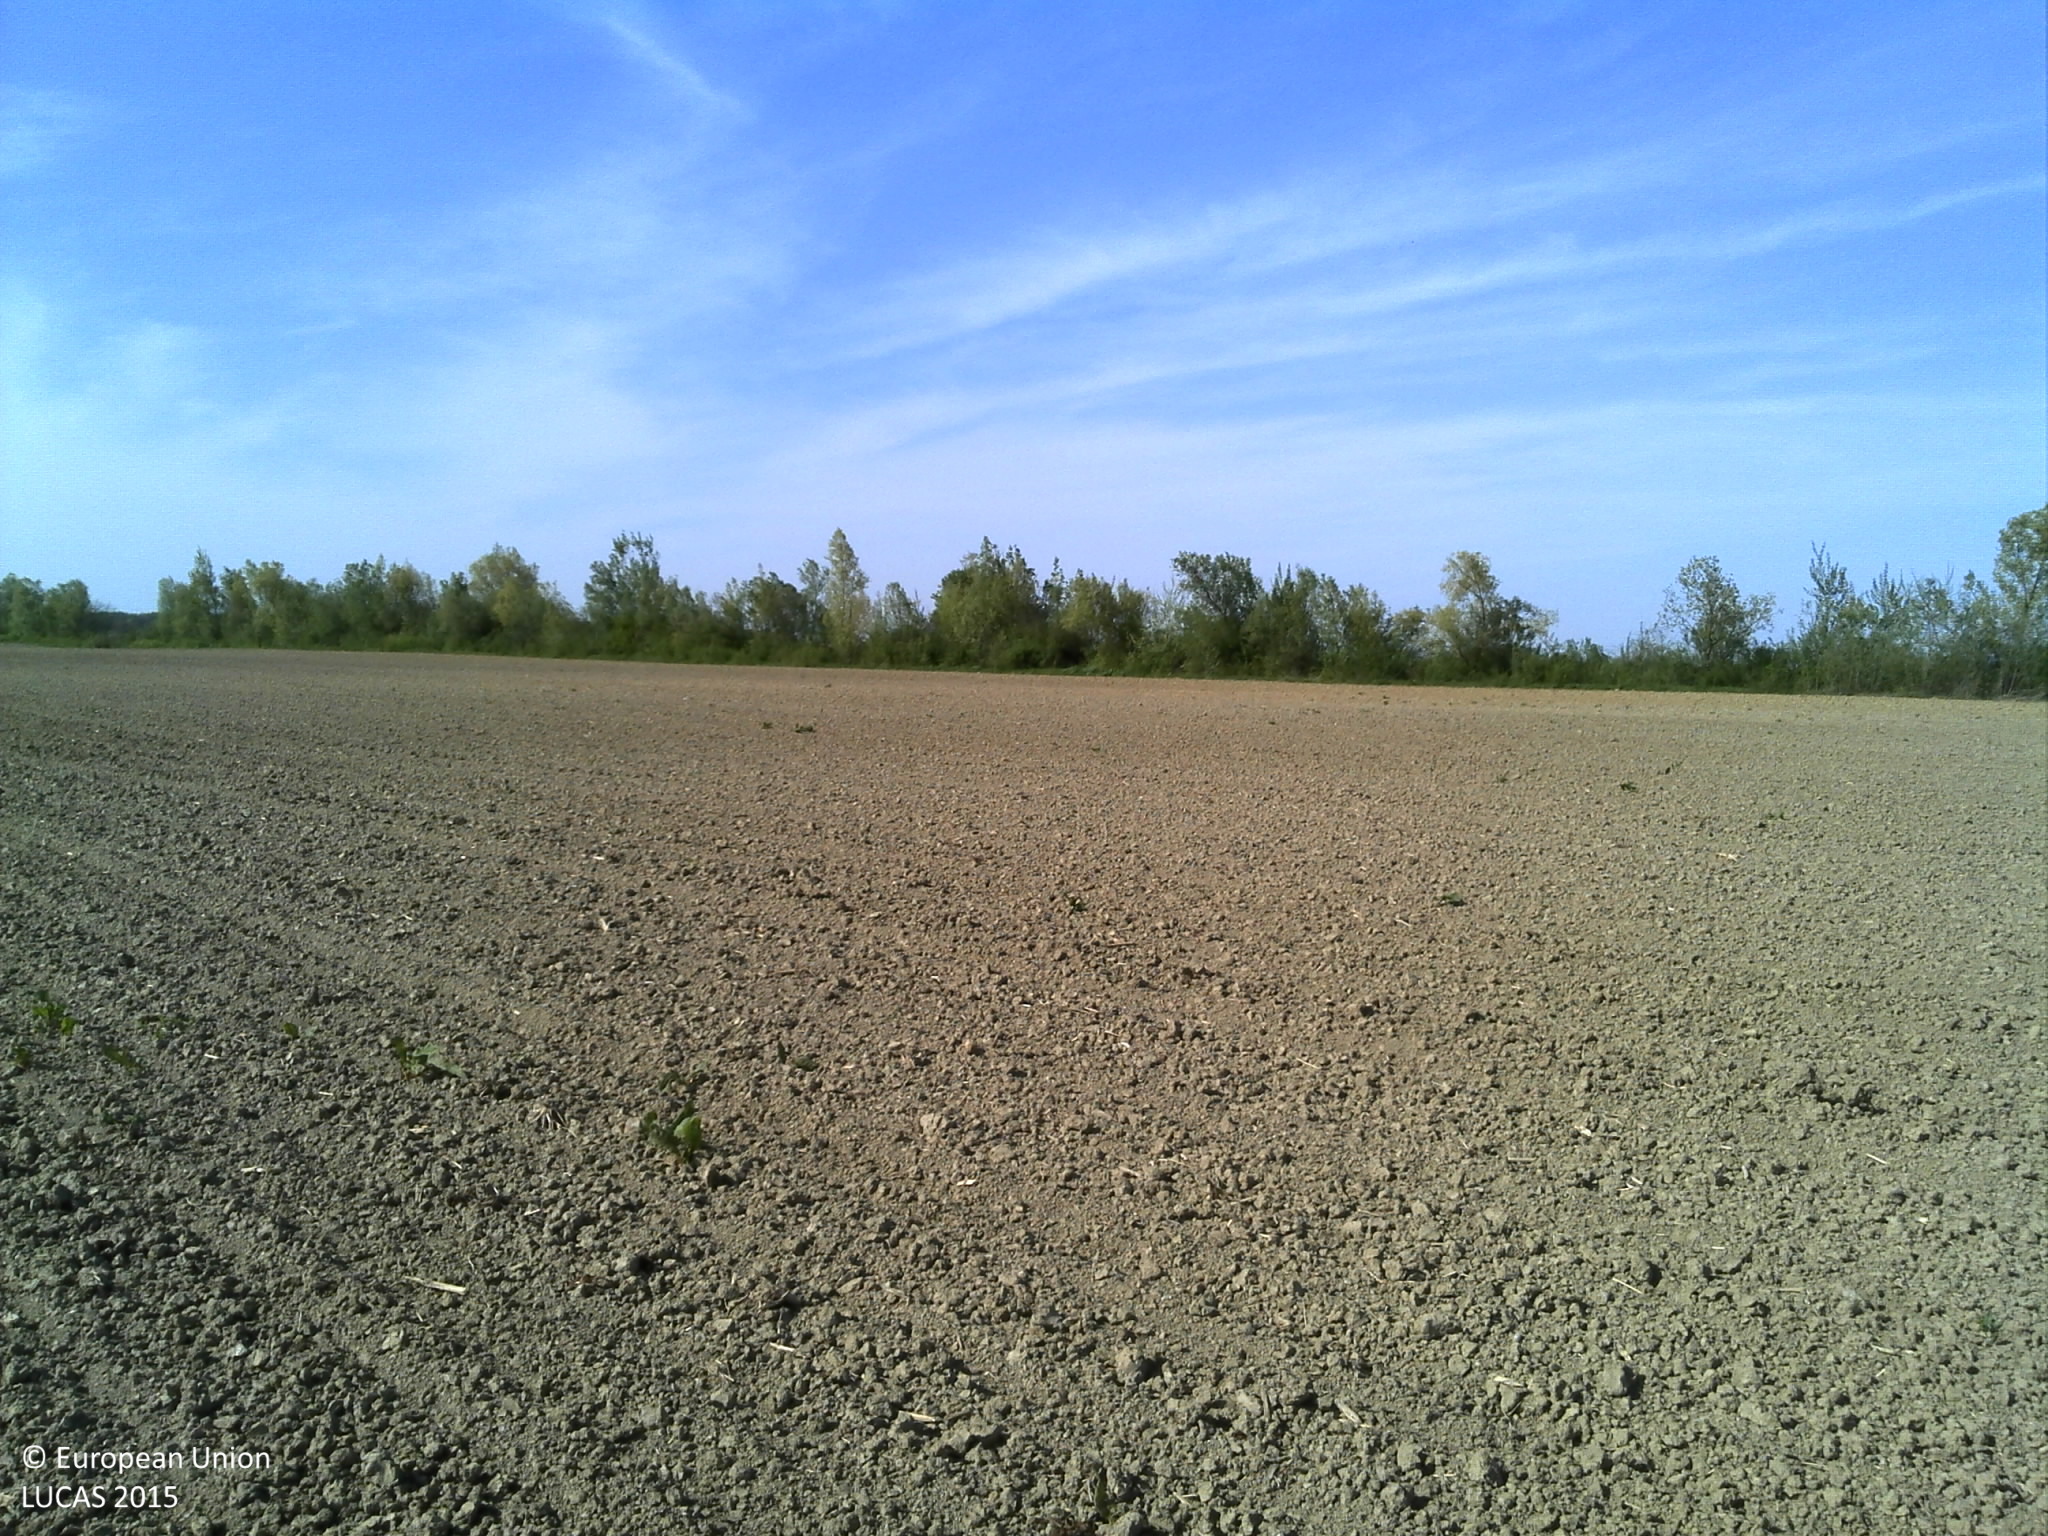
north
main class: Cropland
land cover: Soya
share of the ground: < 10 %
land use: Agriculture (excluding fallow land and kitchen gardens)
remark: Tilled/Sowed
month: April
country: HR
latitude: 44.9274
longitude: 18.9131
